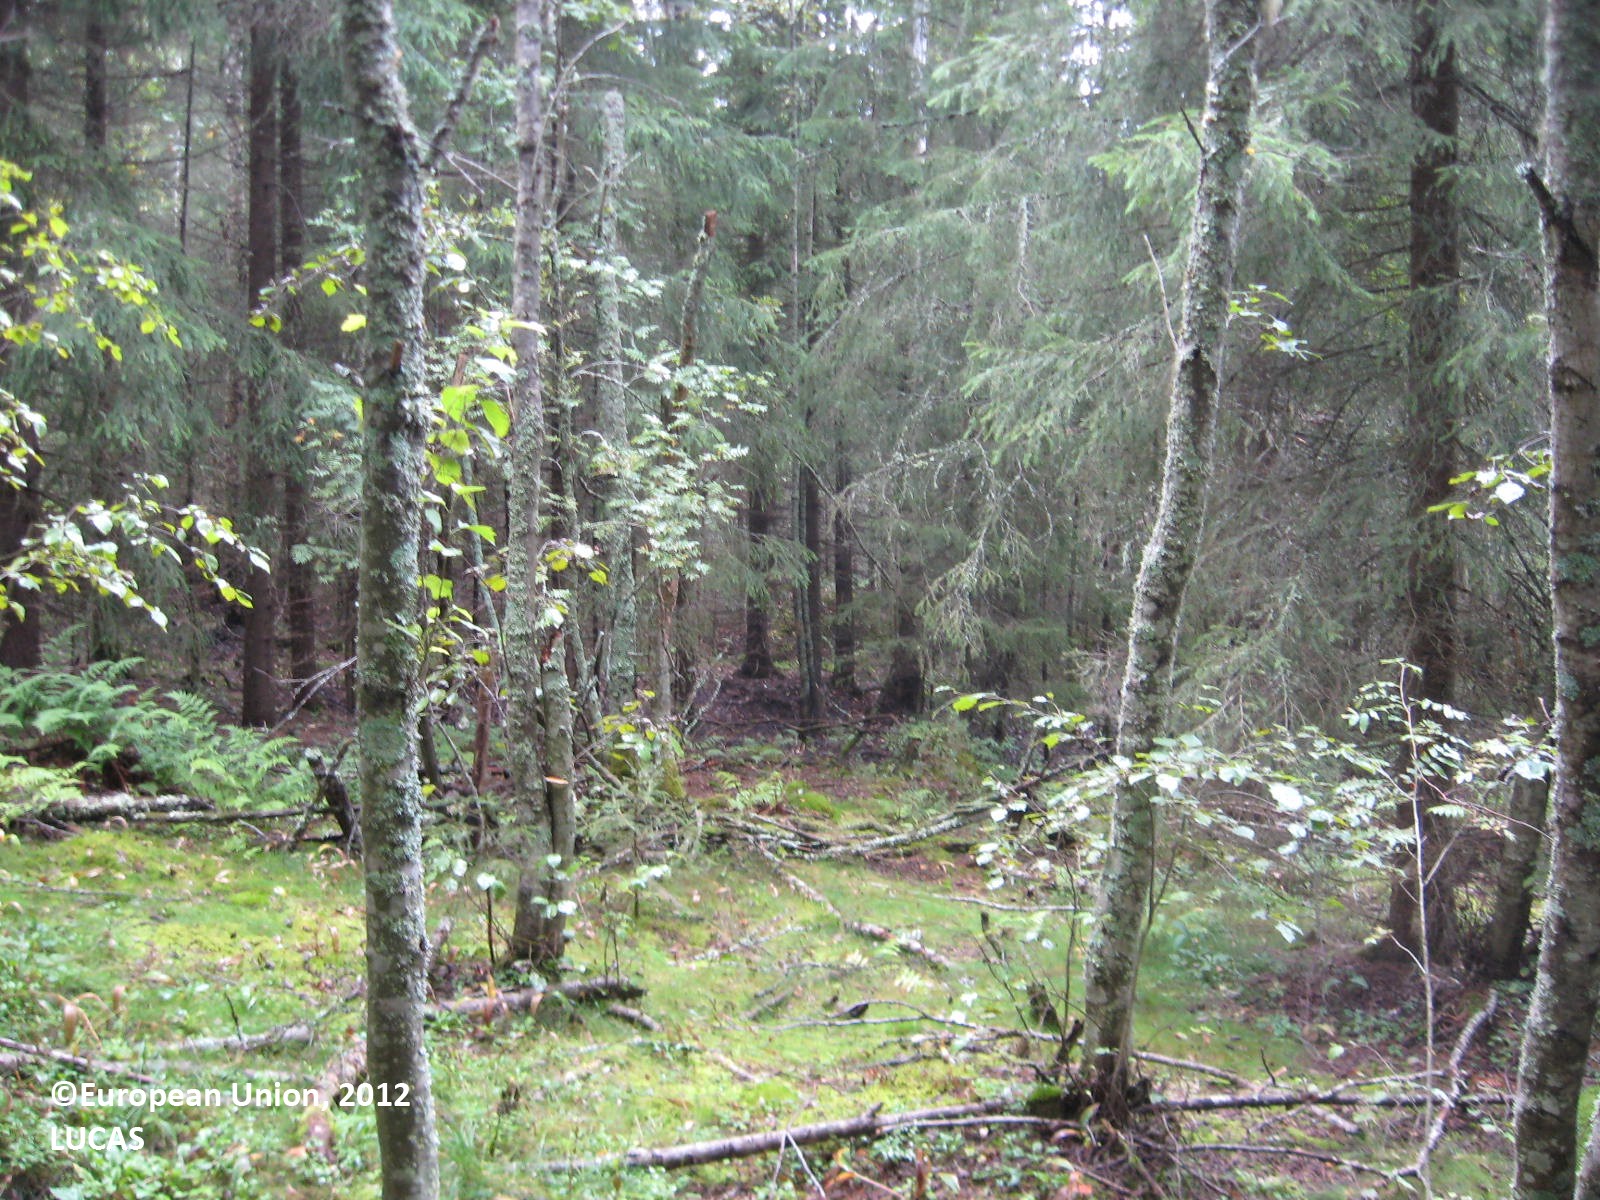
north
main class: Woodland
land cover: Other mixed woodland
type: boreal forest
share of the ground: > 75 %
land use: Forestry
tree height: > 5 m
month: August
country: FI
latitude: 63.5793
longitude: 29.2102
